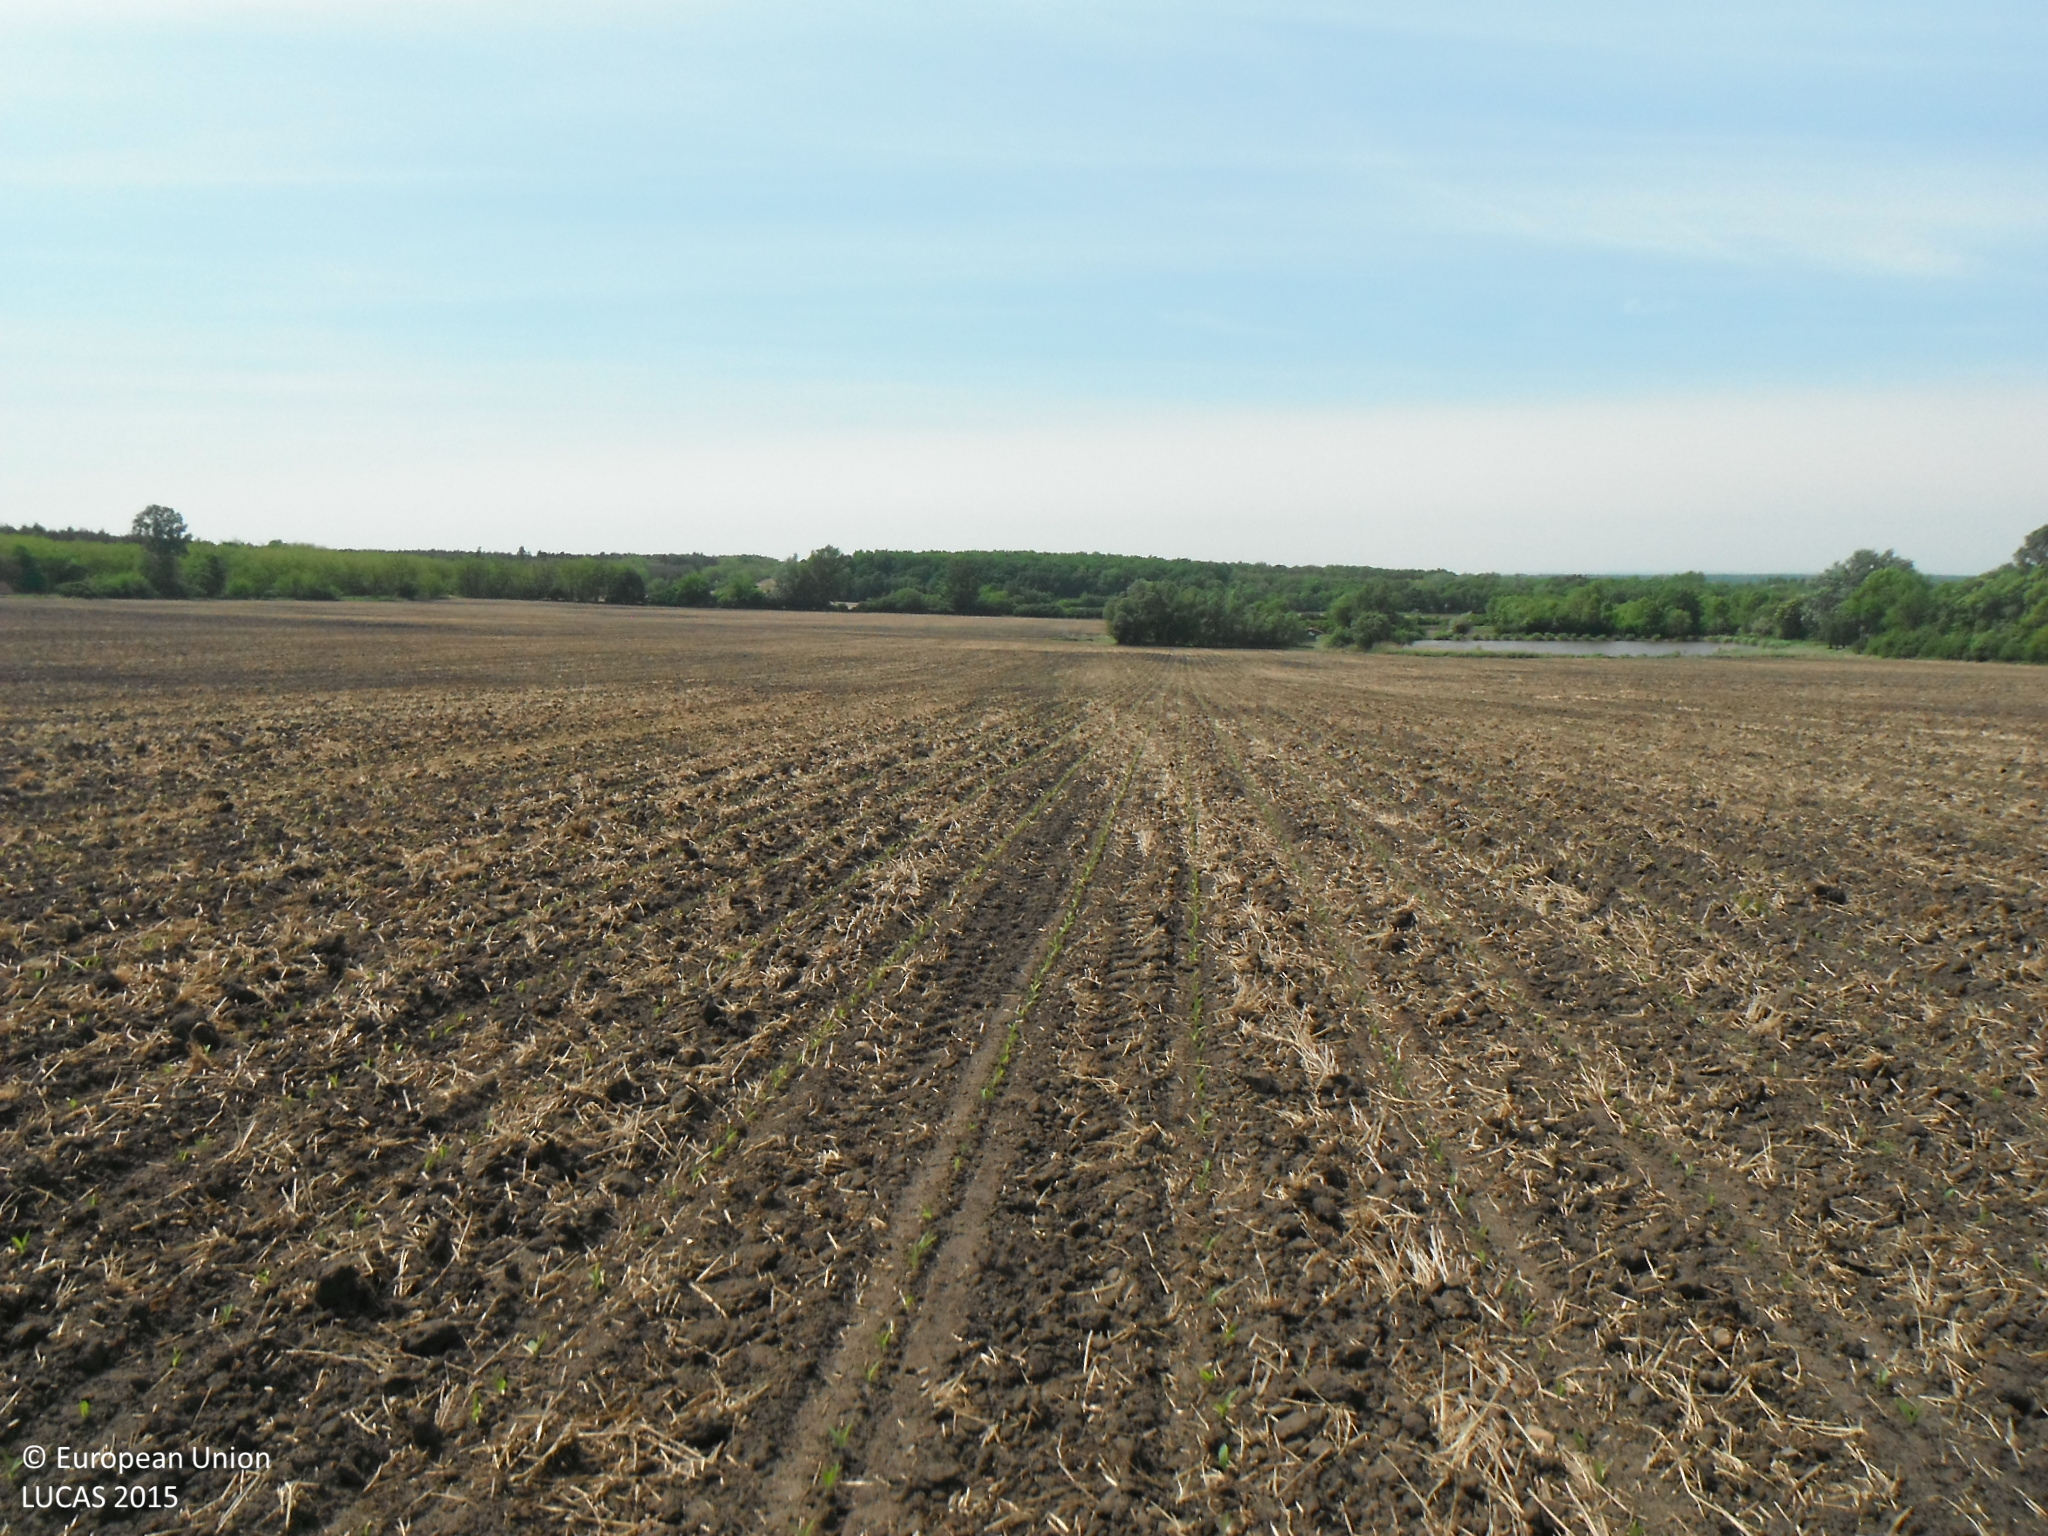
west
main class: Cropland
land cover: Maize
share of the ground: < 10 %
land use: Agriculture (excluding fallow land and kitchen gardens)
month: May
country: SK
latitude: 48.2718
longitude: 17.0004
